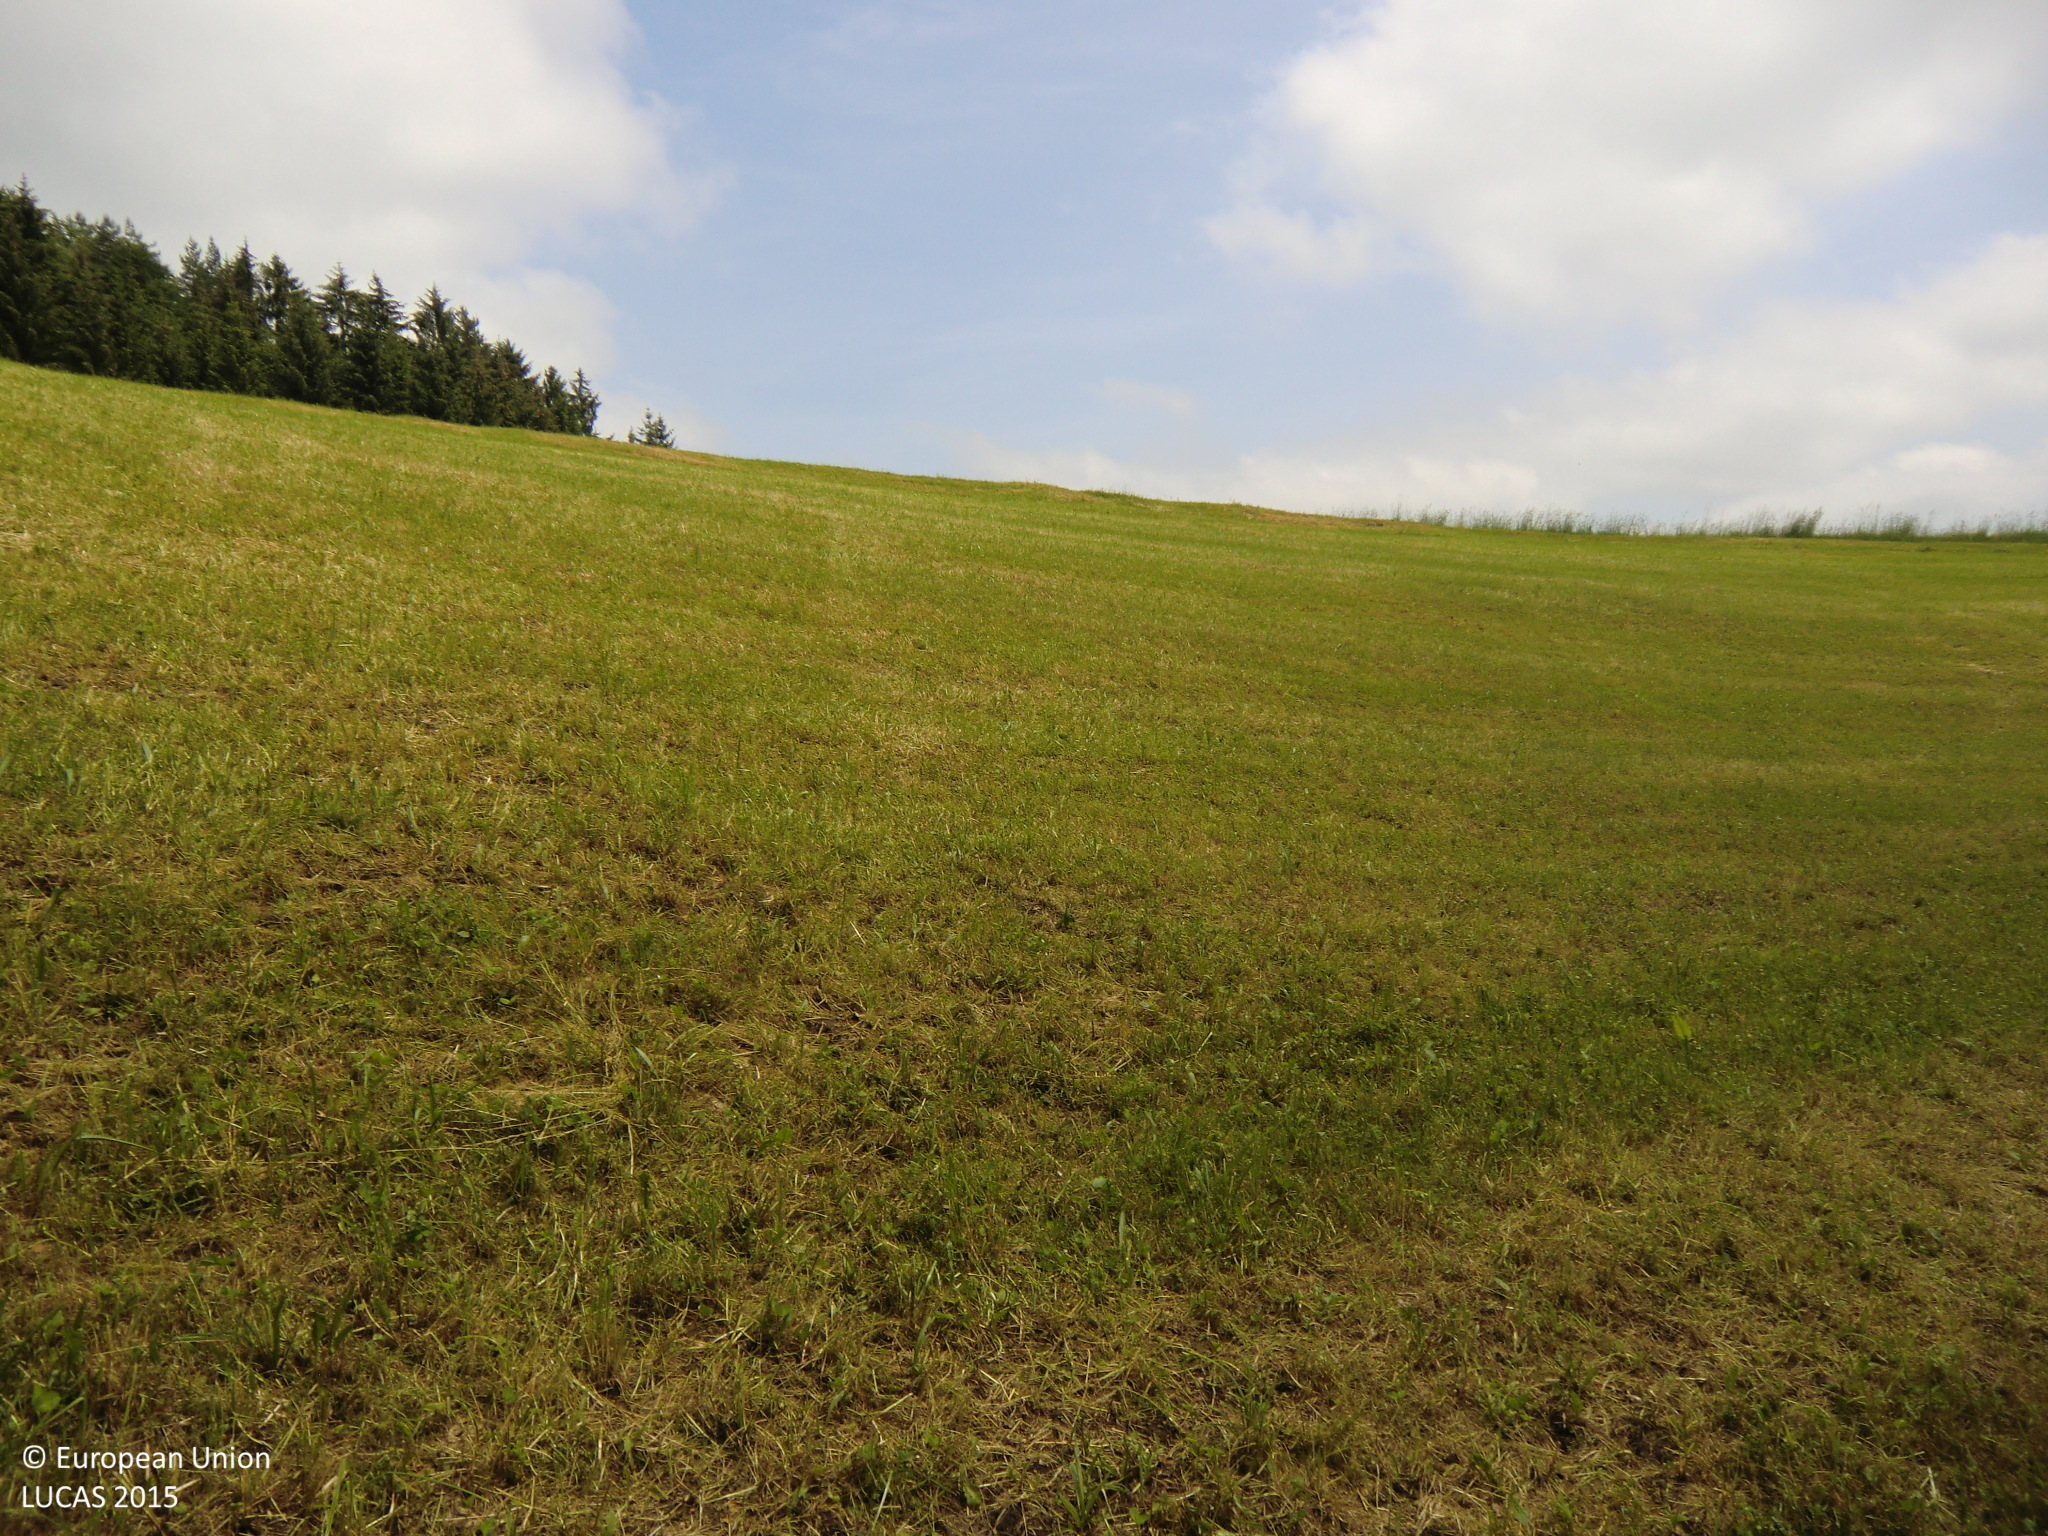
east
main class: Grassland
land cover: Grassland without tree/shrub cover
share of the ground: > 75 %
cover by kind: herbaceous plants 90 %, consolidated bare surface 10 %
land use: Agriculture (excluding fallow land and kitchen gardens)
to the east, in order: Grassland without tree/shrub cover; Tracks; Grassland without tree/shrub cover; Tracks; Common wheat; Electric lines; Common wheat; Tracks; Spruce dominated coniferous woodland
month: June
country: AT
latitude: 48.4447
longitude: 14.7733
